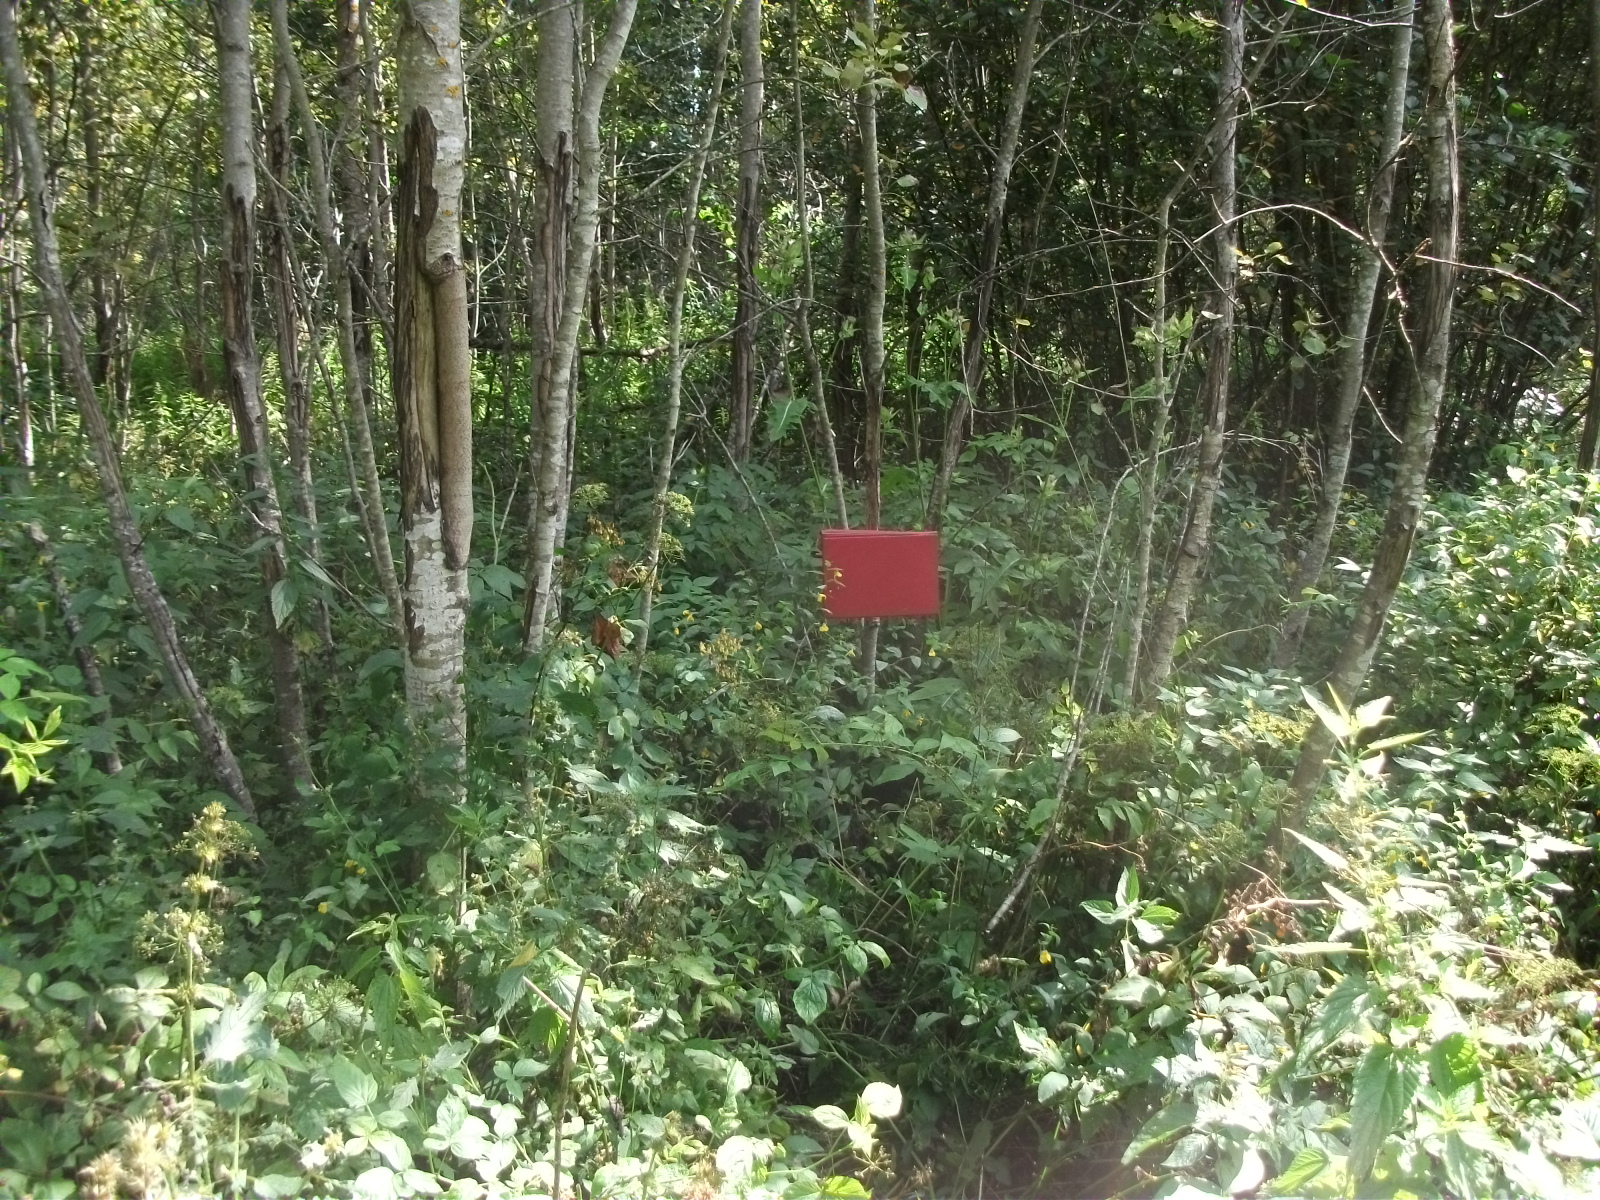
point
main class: Woodland
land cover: Broadleaved woodland
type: non-riverine alder, birch or aspen forest
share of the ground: 50 - 75 %
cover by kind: broadleaved forest trees 70 %, herbaceous plants 20 %, shrubs 10 %
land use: Forestry
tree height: > 5 m
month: August
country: LV
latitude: 56.8697
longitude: 26.4008
